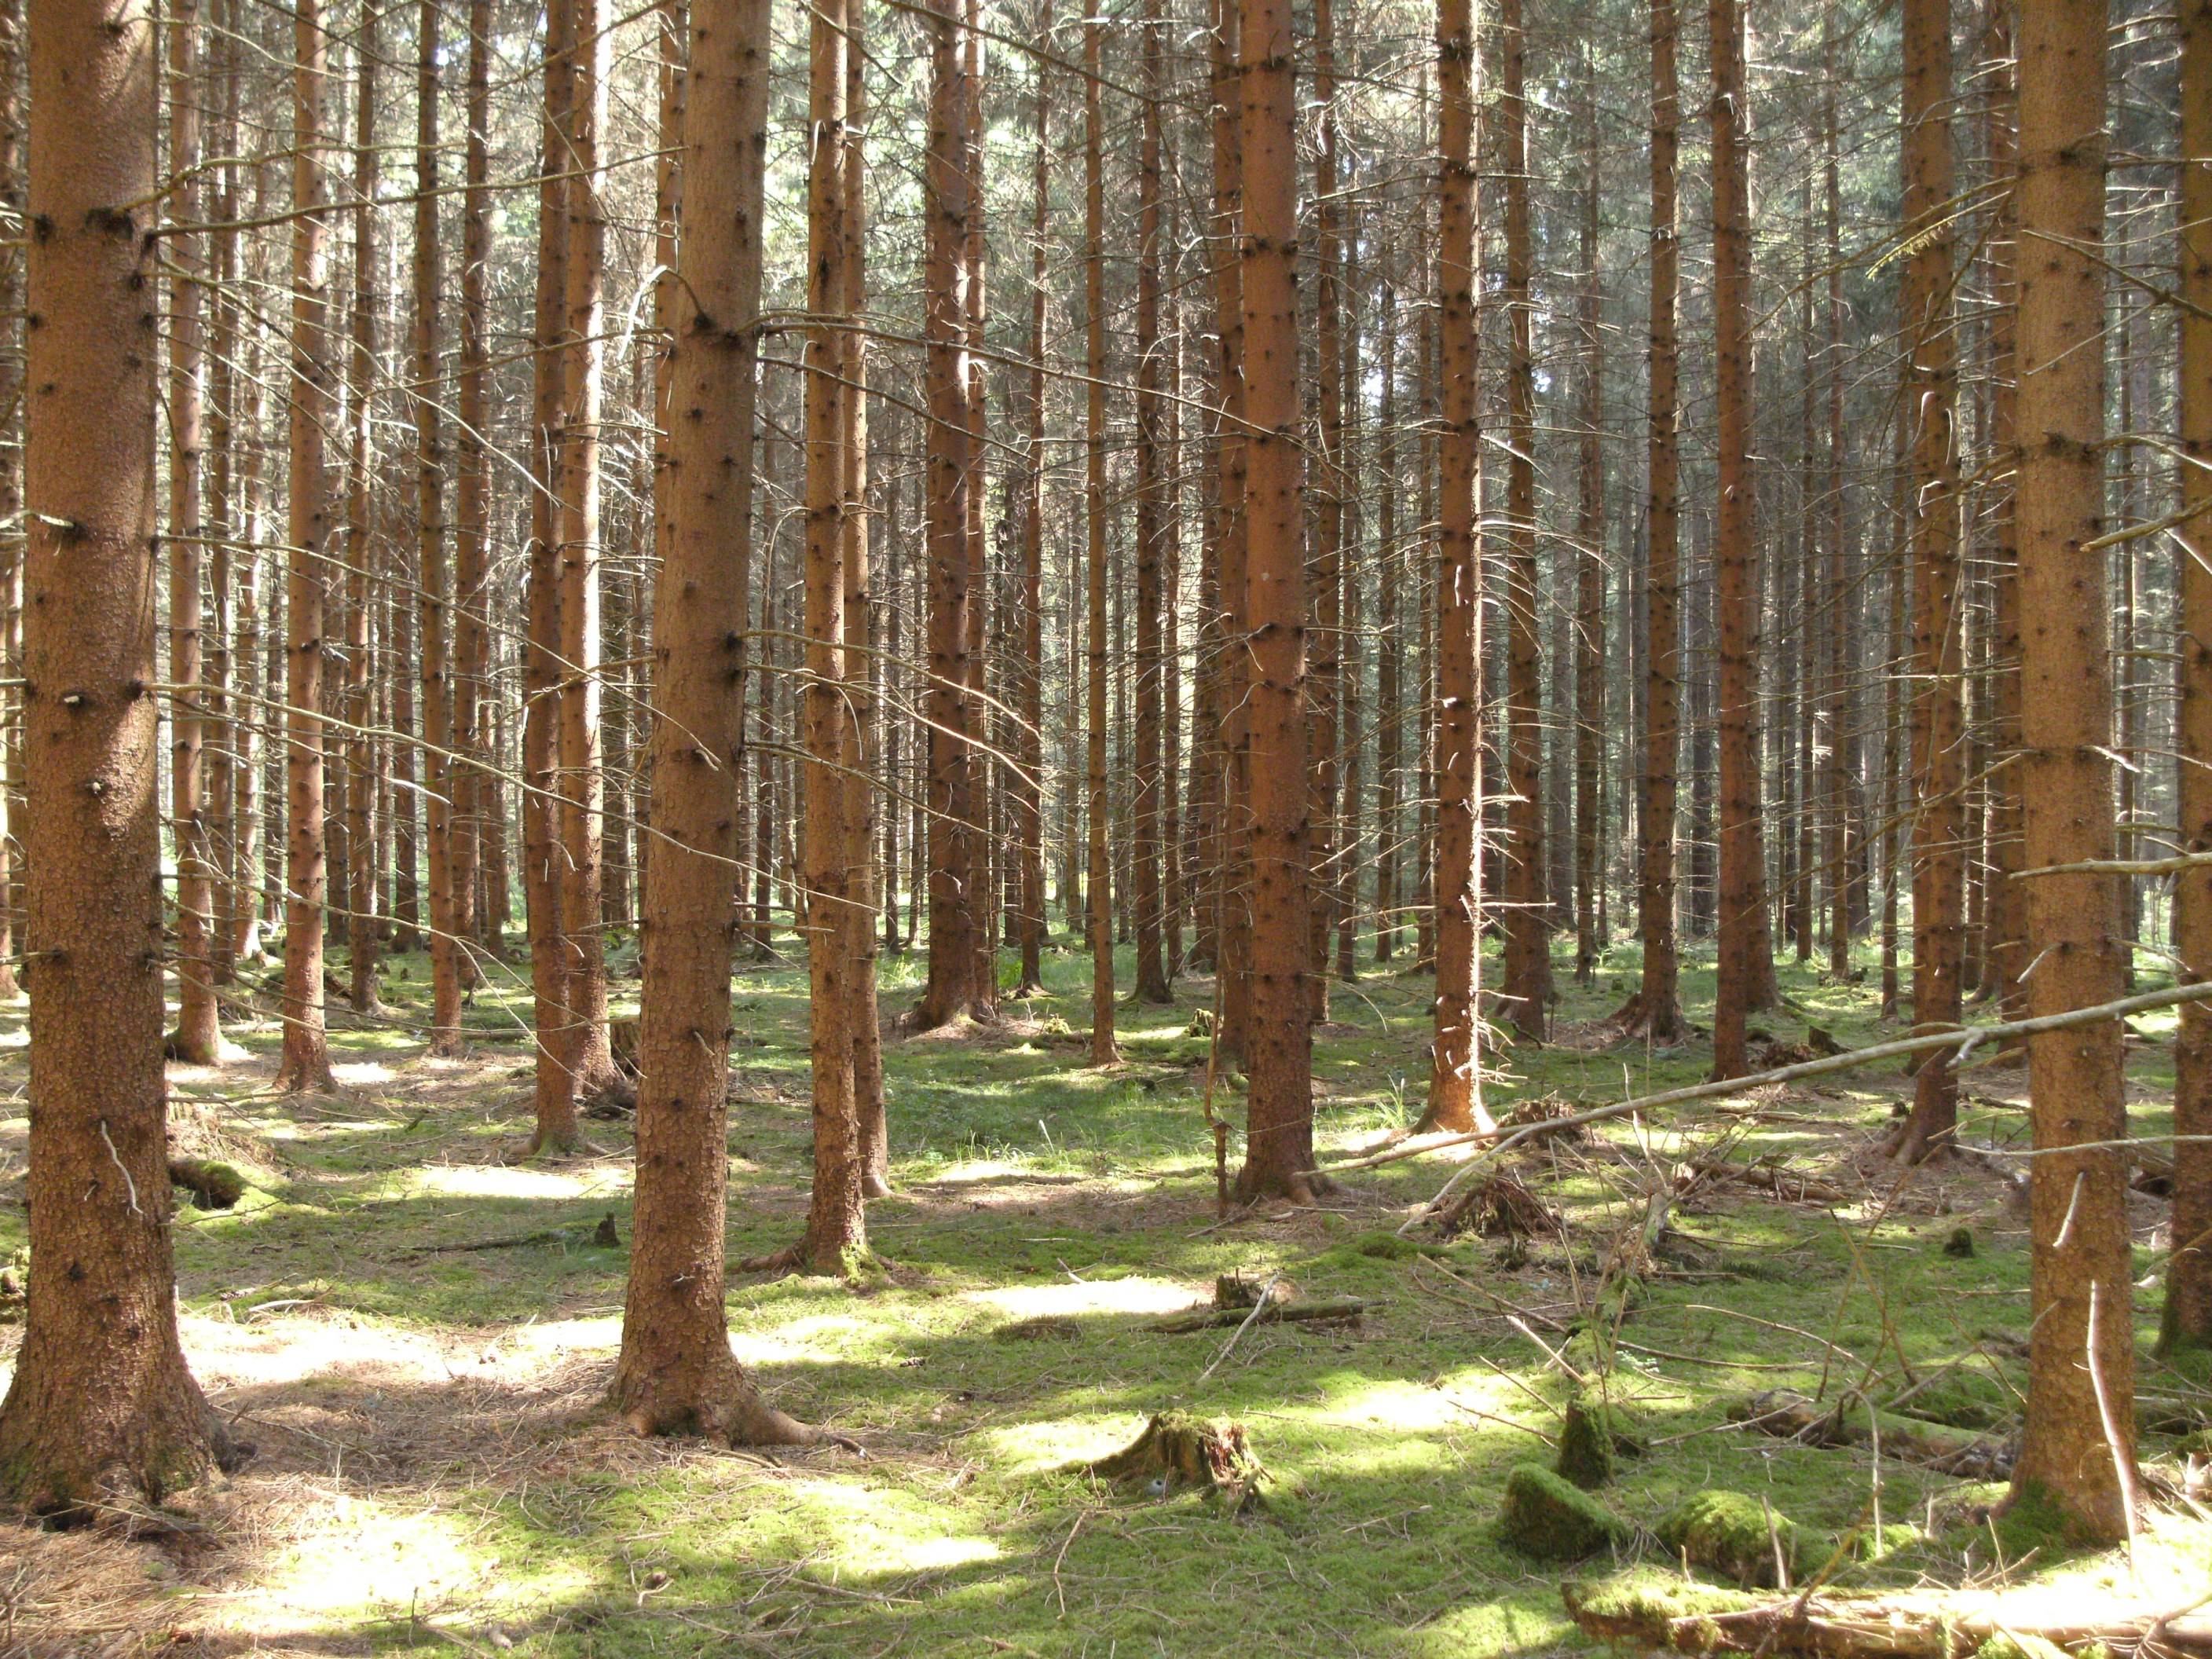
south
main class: Woodland
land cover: Spruce dominated coniferous woodland
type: hemiboreal forest and nemoral coniferous forest and mixed broadleaved-coniferous forest
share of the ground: > 75 %
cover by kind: coniferous forest trees 90 %, lichens and mosses 5 %, unconsolidated bare surface 5 %
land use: Forestry
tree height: > 5 m
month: July
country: AT
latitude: 46.7259
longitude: 14.9049
